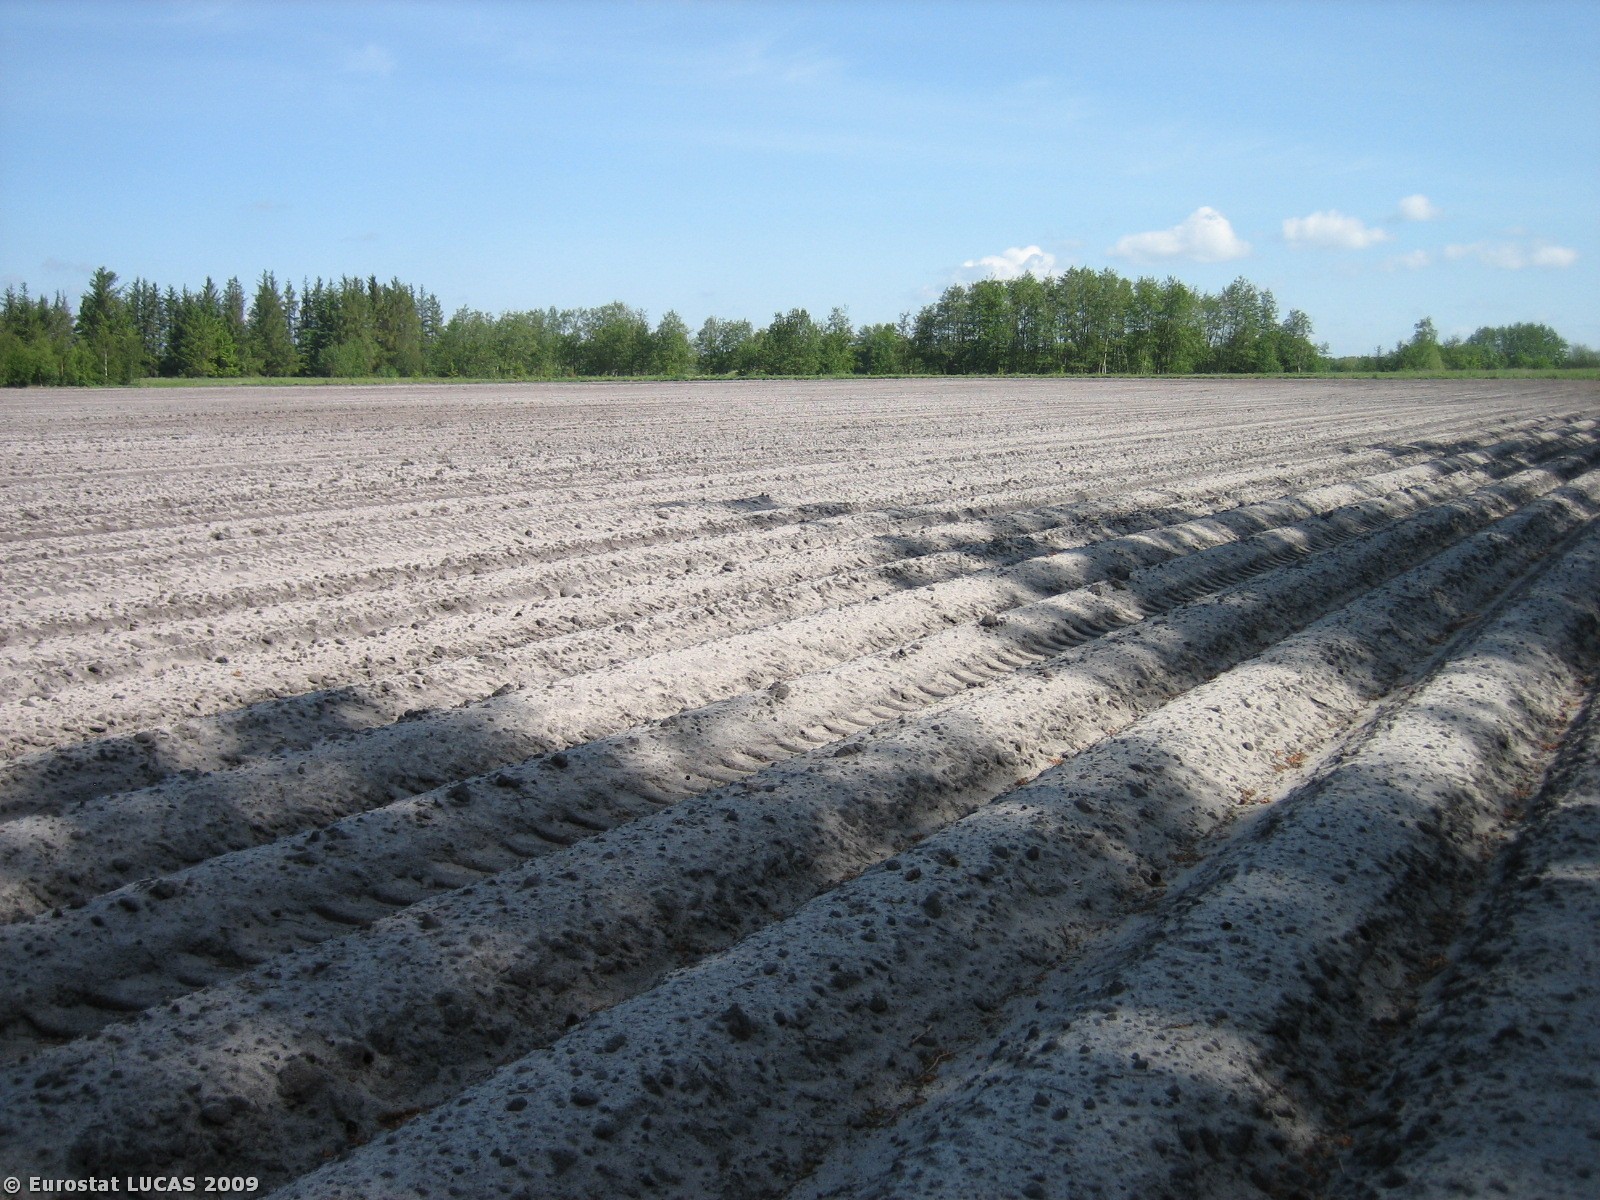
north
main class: Cropland
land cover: Potatoes
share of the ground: < 10 %
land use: Agriculture (excluding fallow land and kitchen gardens)
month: May
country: DK
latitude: 56.1851
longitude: 9.1793
